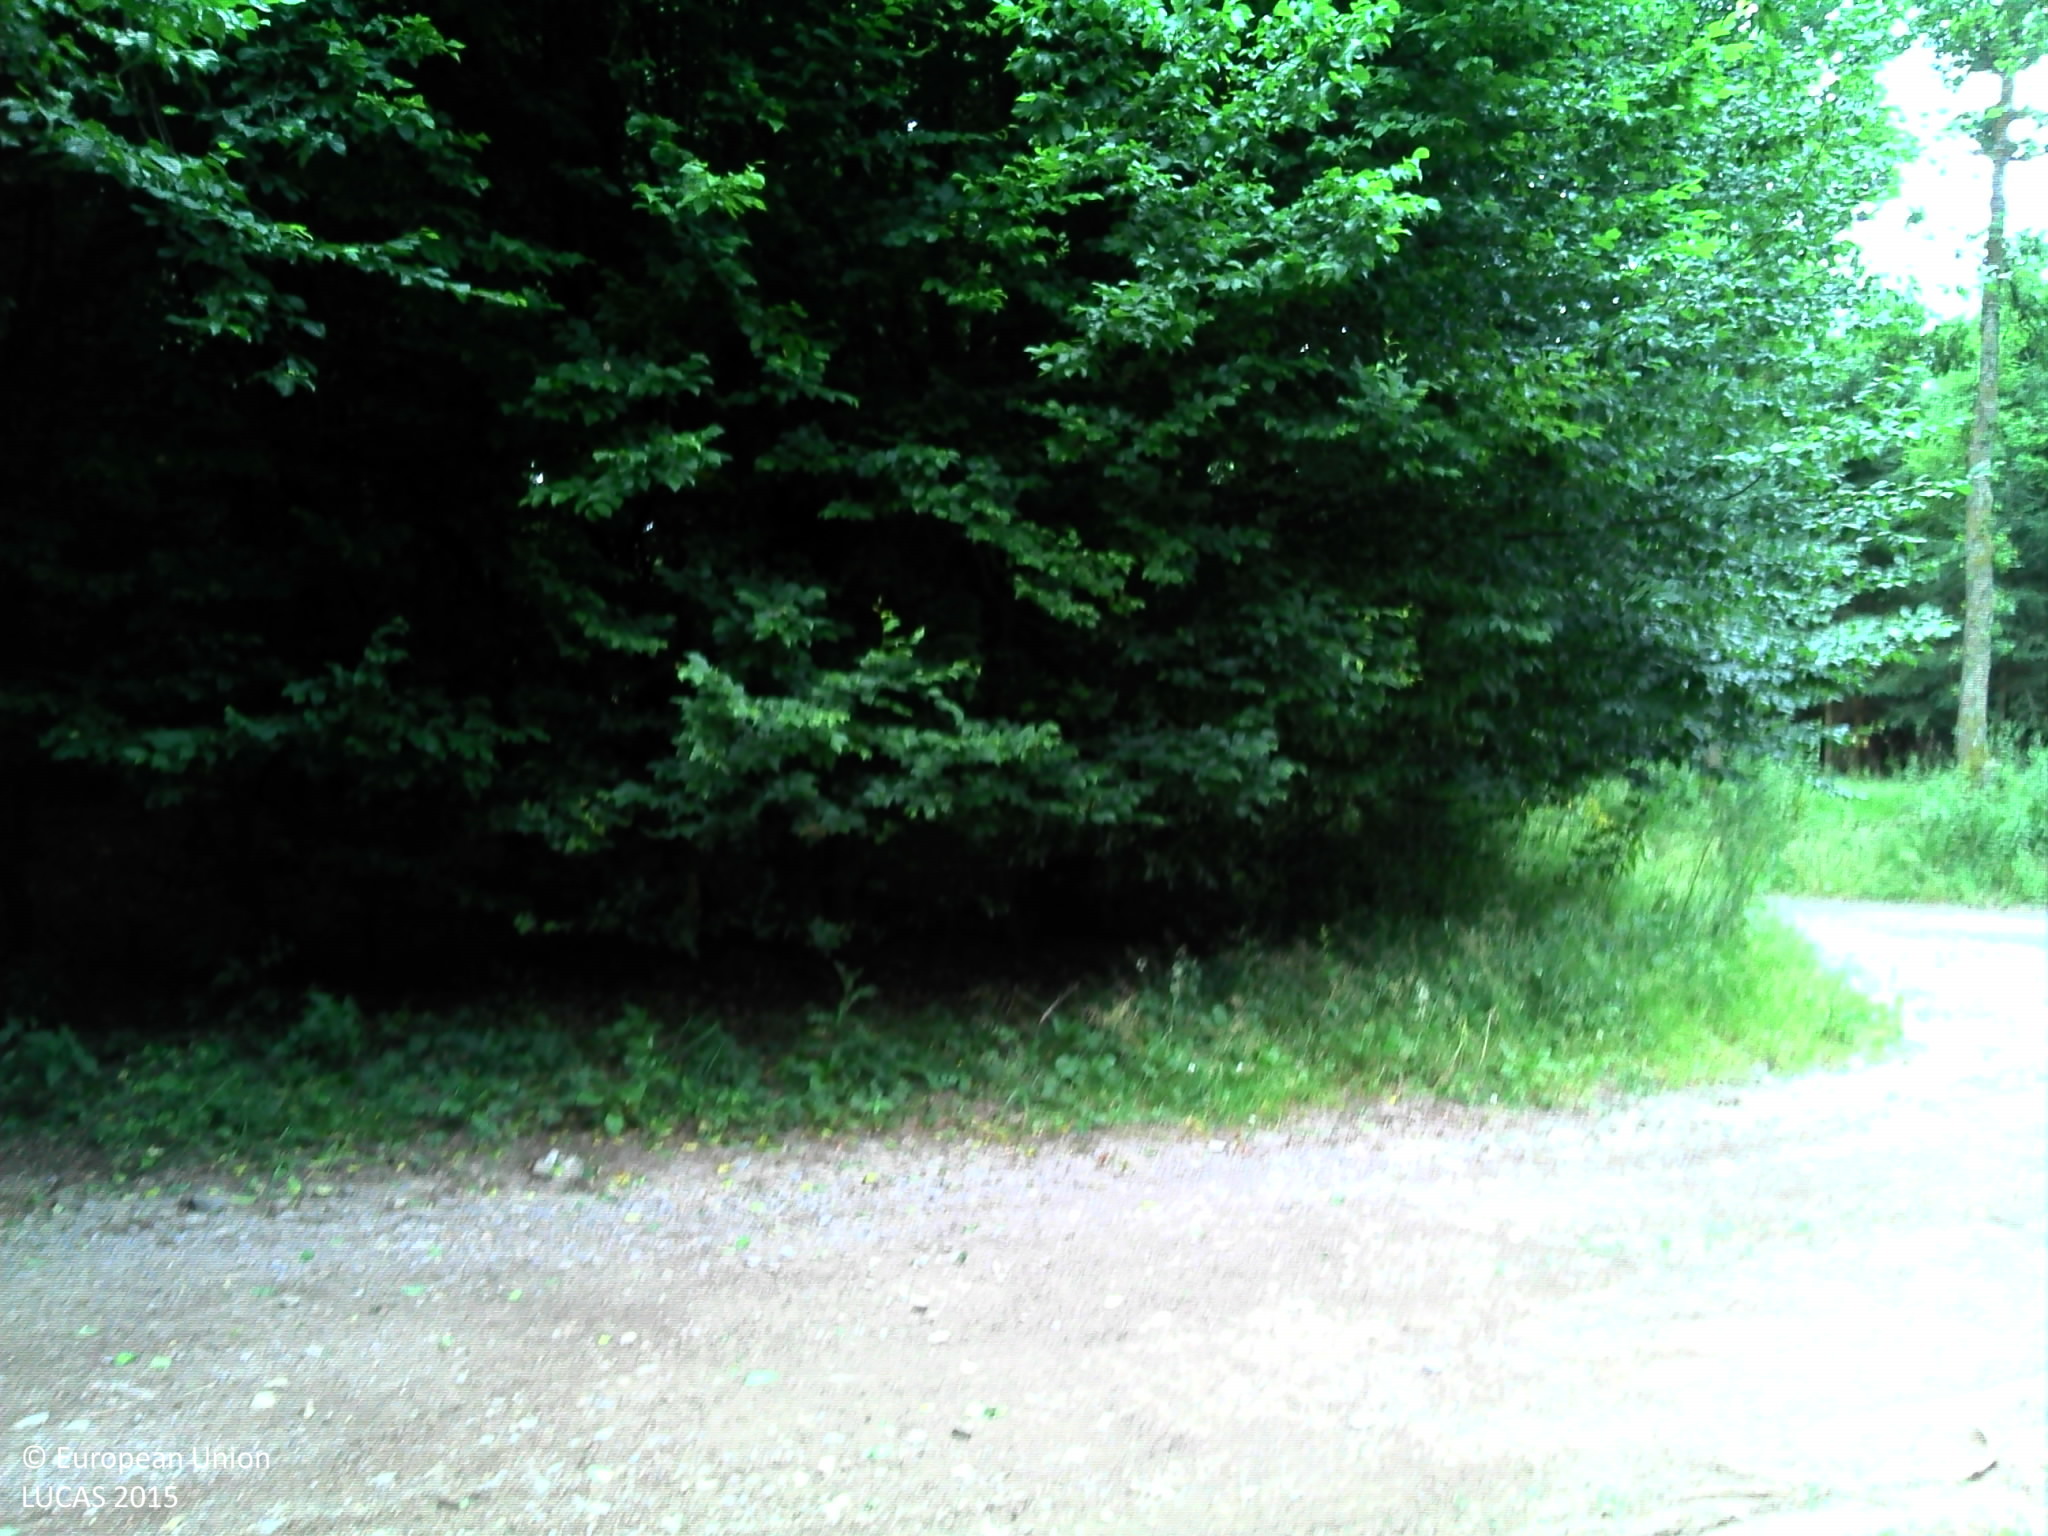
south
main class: Woodland
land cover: Spruce dominated coniferous woodland
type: hemiboreal forest and nemoral coniferous forest and mixed broadleaved-coniferous forest
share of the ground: > 75 %
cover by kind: coniferous forest trees 100 %
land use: Forestry
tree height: > 5 m
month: July
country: BE
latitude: 50.1794
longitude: 5.8118
